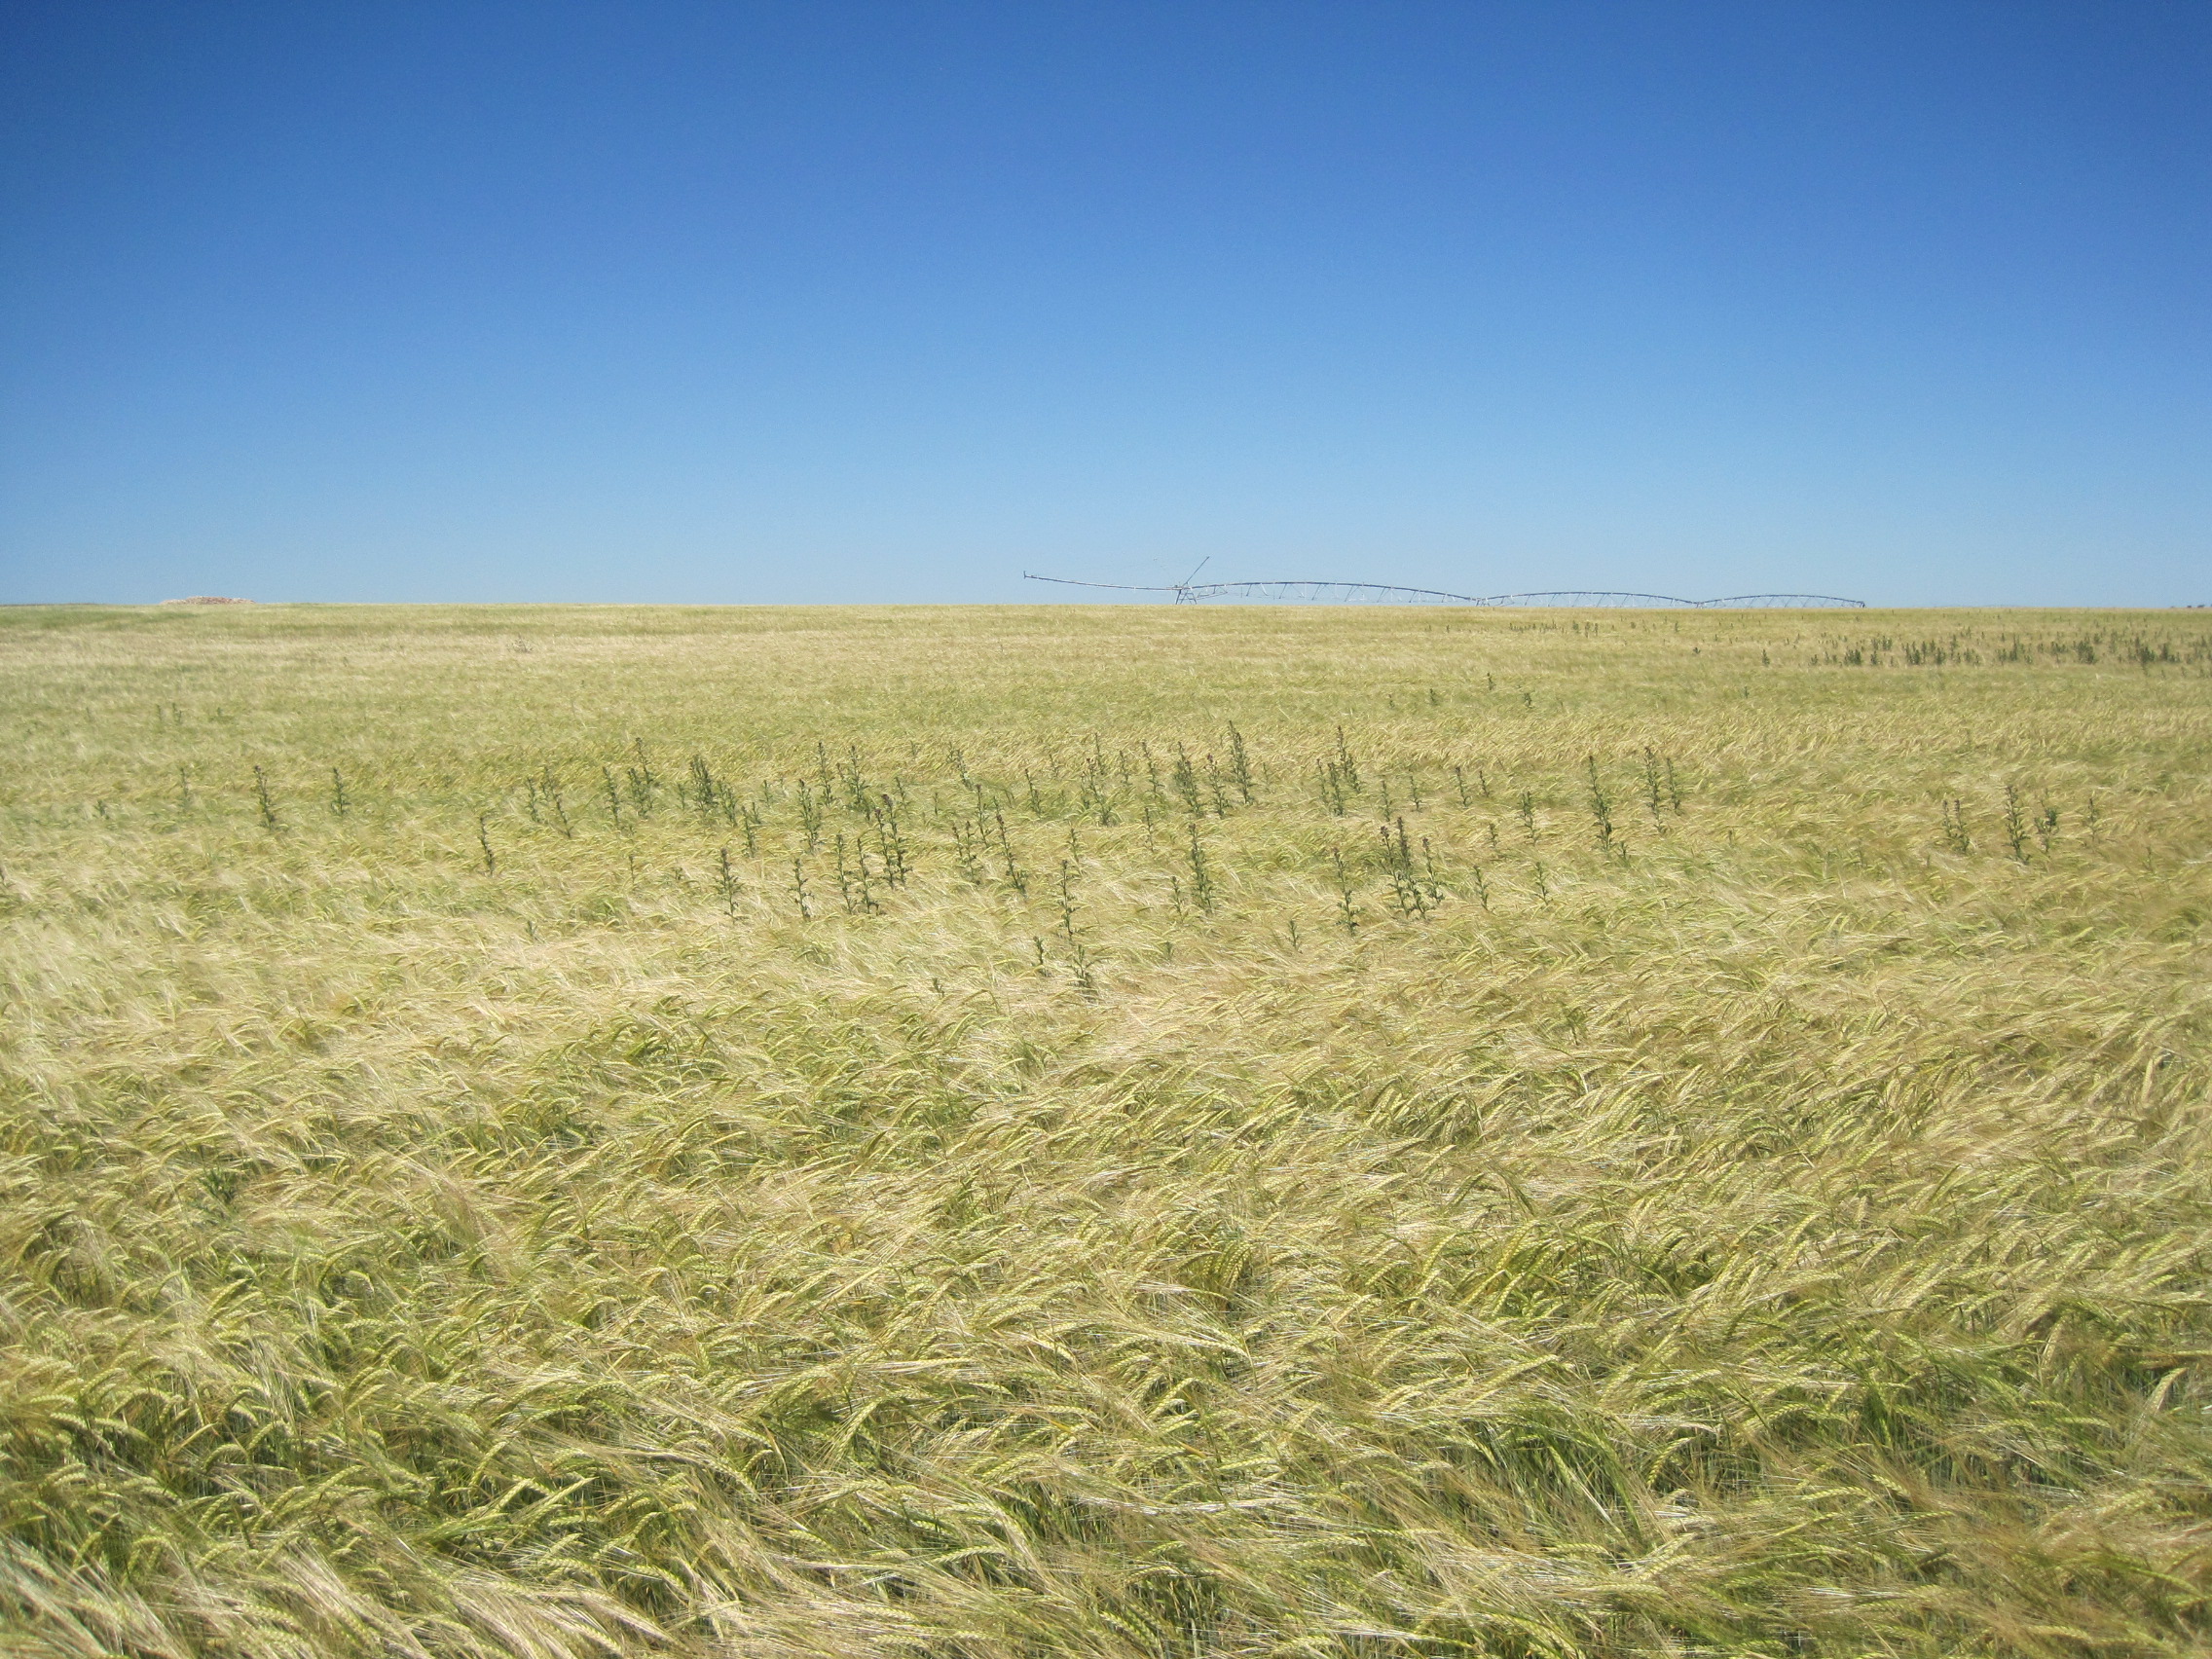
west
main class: Cropland
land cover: Barley
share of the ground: > 75 %
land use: Agriculture (excluding fallow land and kitchen gardens)
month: May
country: ES
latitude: 41.2822
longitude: -5.2976
